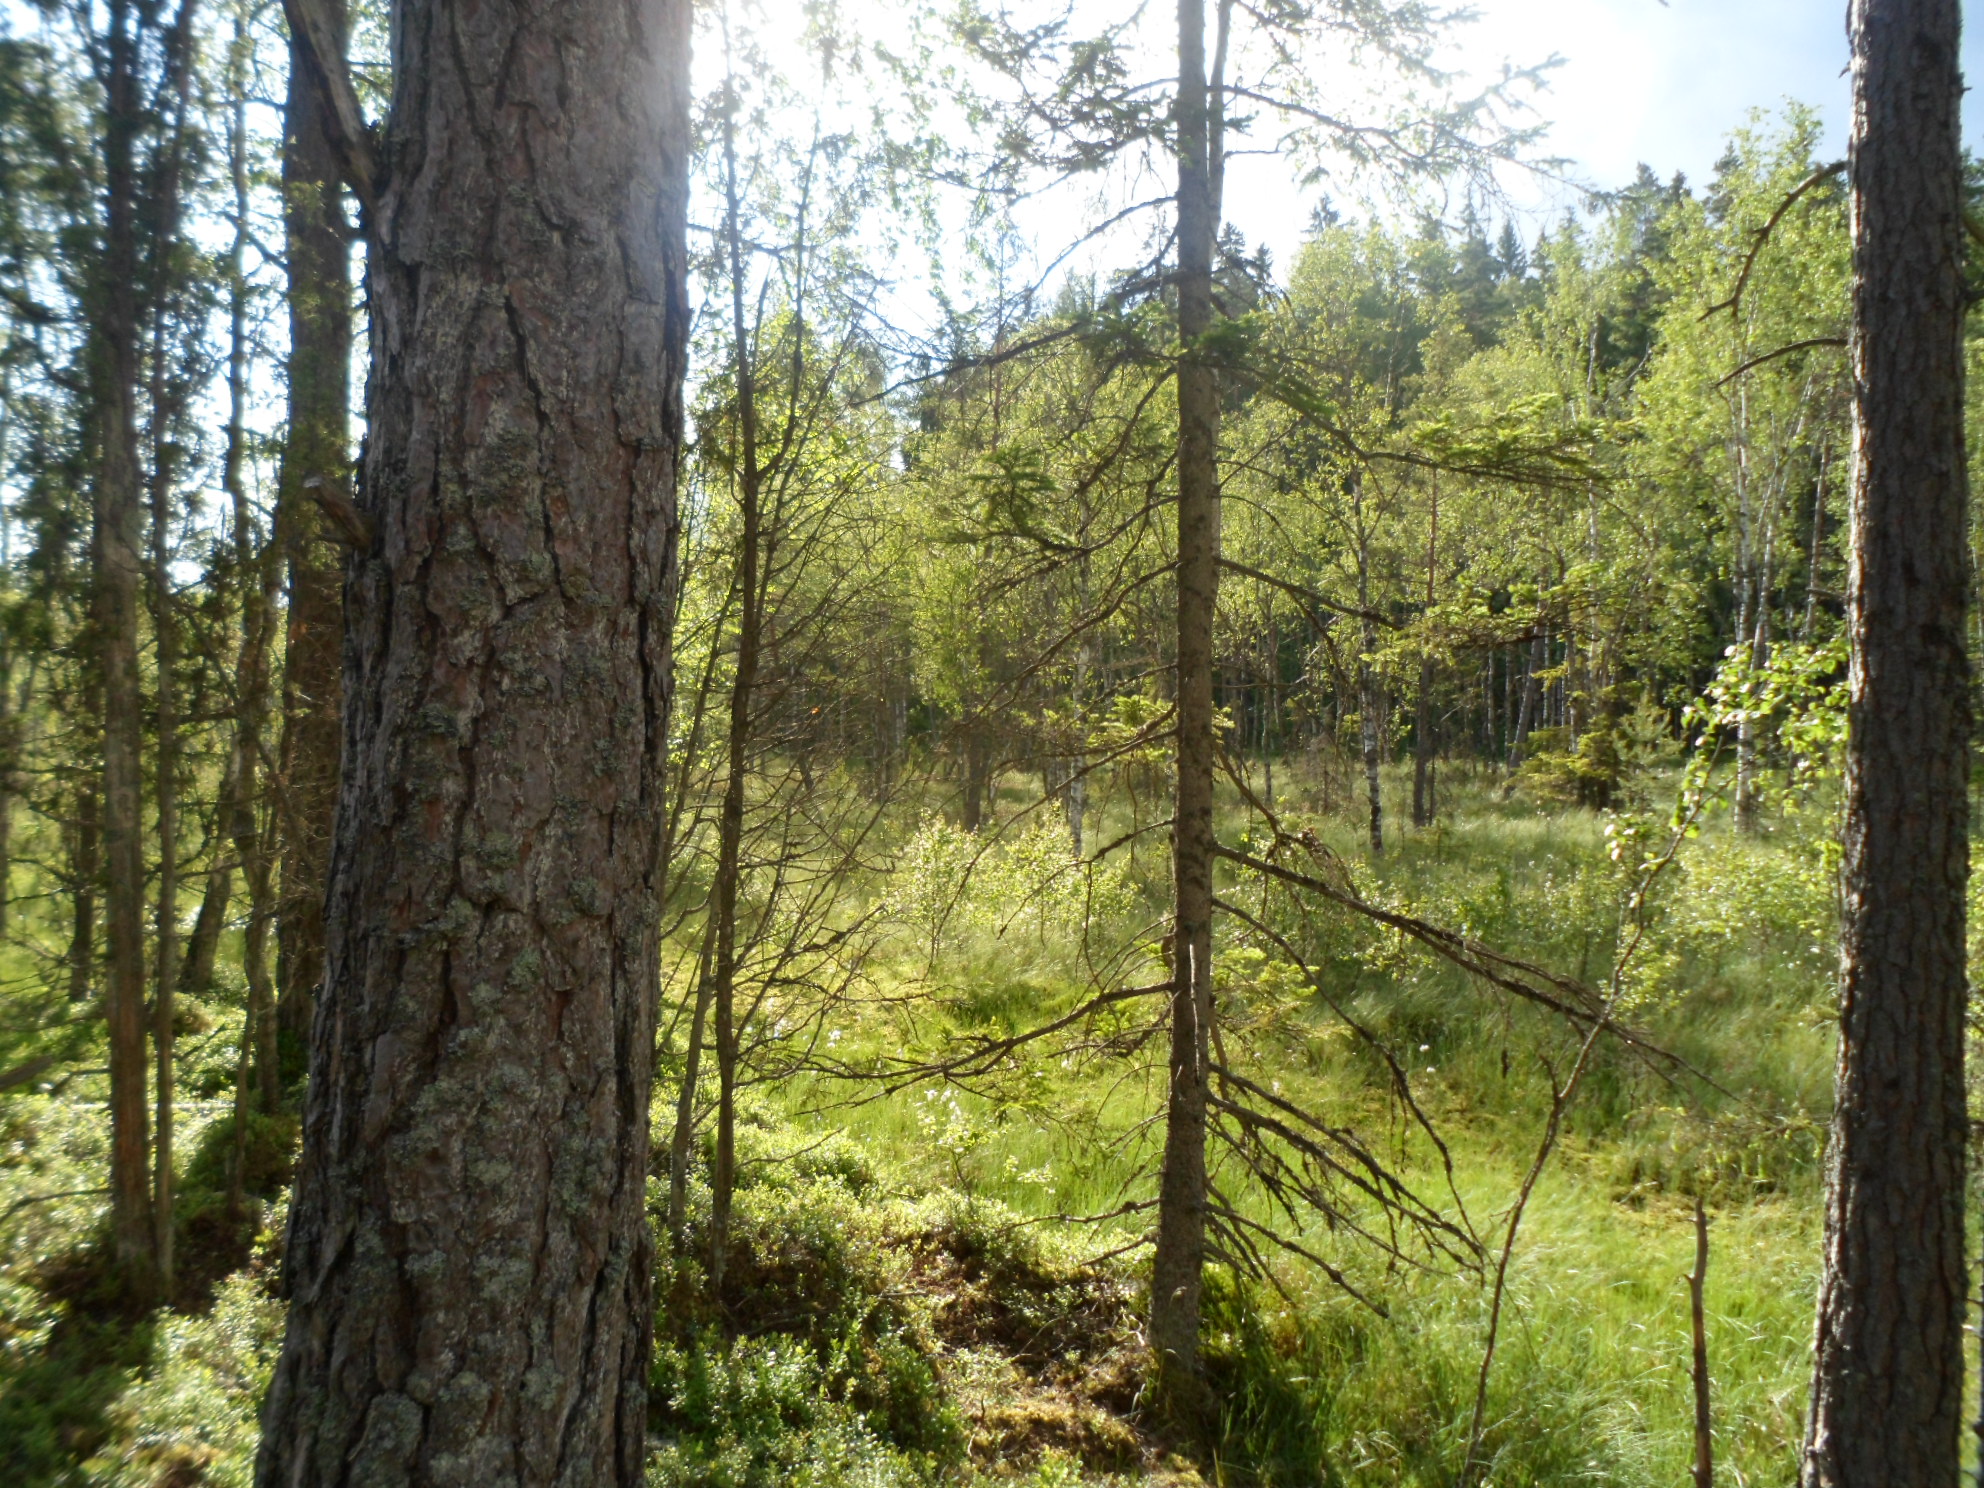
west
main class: Woodland
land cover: Pine dominated coniferous woodland
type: boreal forest
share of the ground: 25 - 50 %
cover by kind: coniferous forest trees 35 %, shrubs 30 %, herbaceous plants 10 %, lichens and mosses 10 %, unconsolidated bare surface 10 %, broadleaved forest trees 5 %
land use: Forestry
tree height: > 5 m
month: June
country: SE
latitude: 57.2024
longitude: 14.6477
